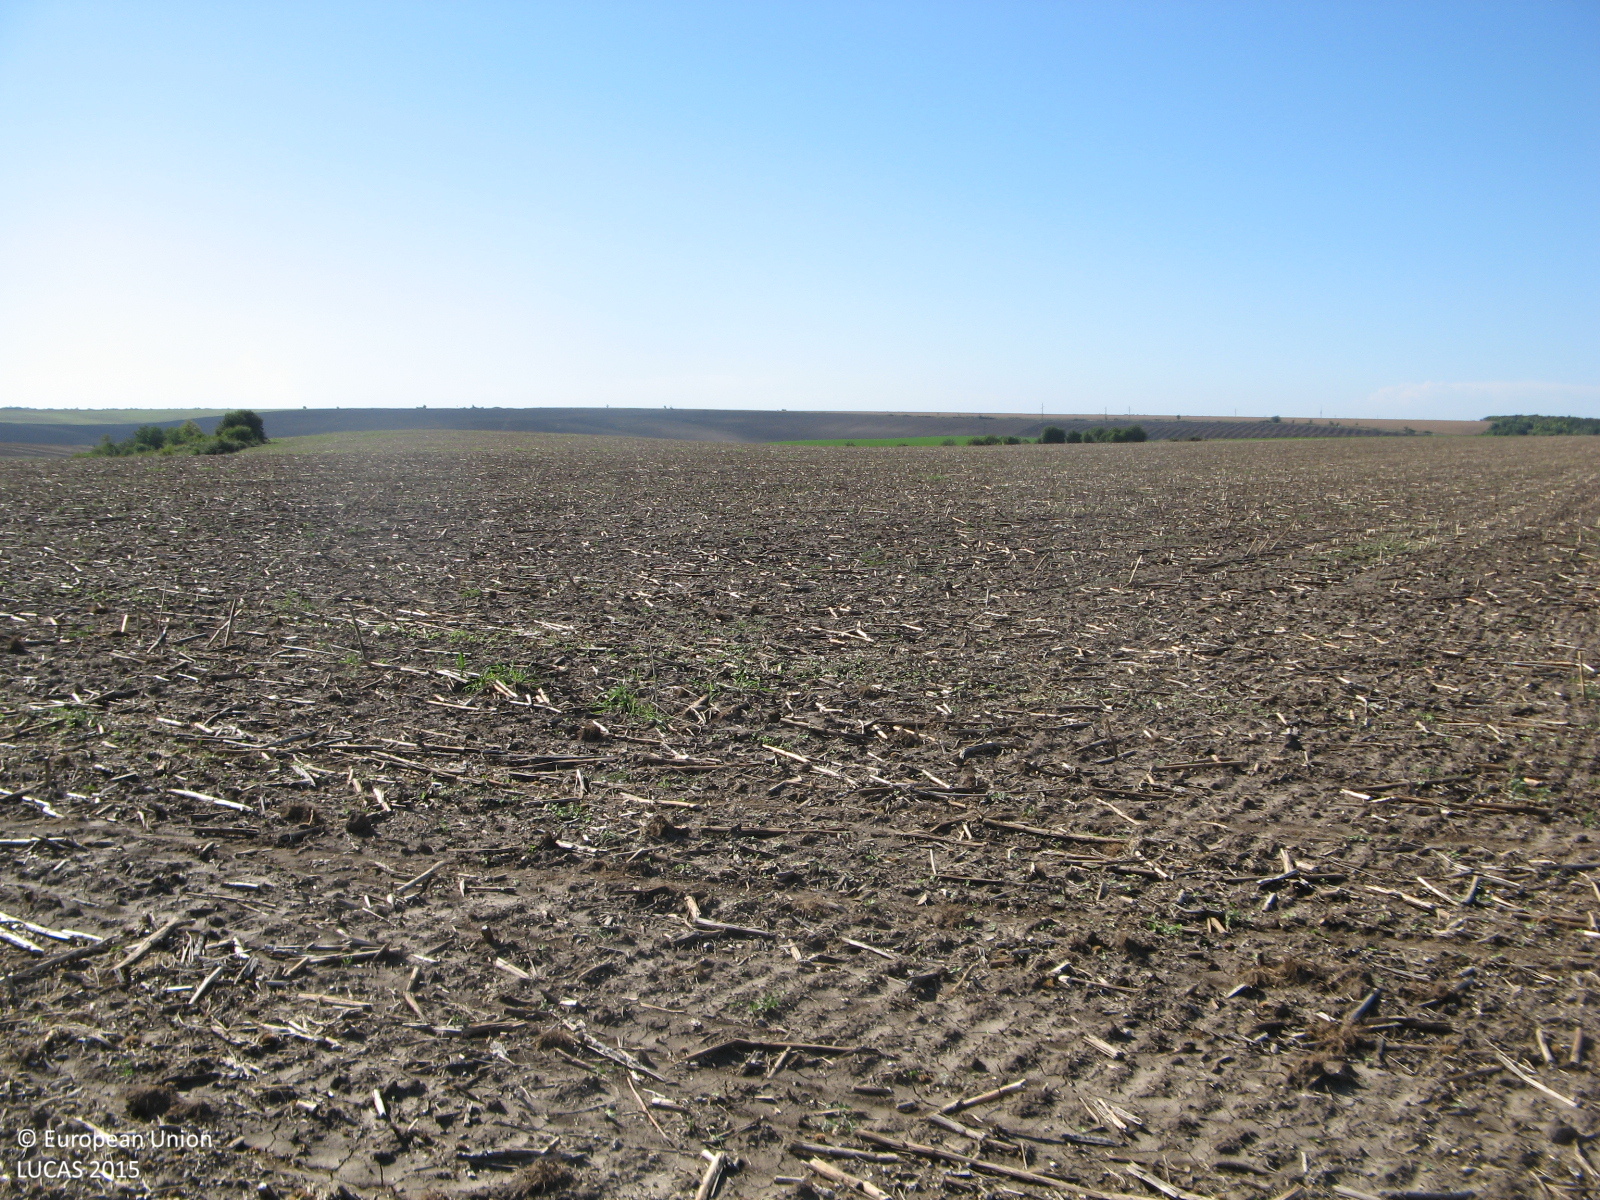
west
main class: Cropland
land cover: Sunflower
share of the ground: < 10 %
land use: Agriculture (excluding fallow land and kitchen gardens)
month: September
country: BG
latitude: 43.7263
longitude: 26.0991
